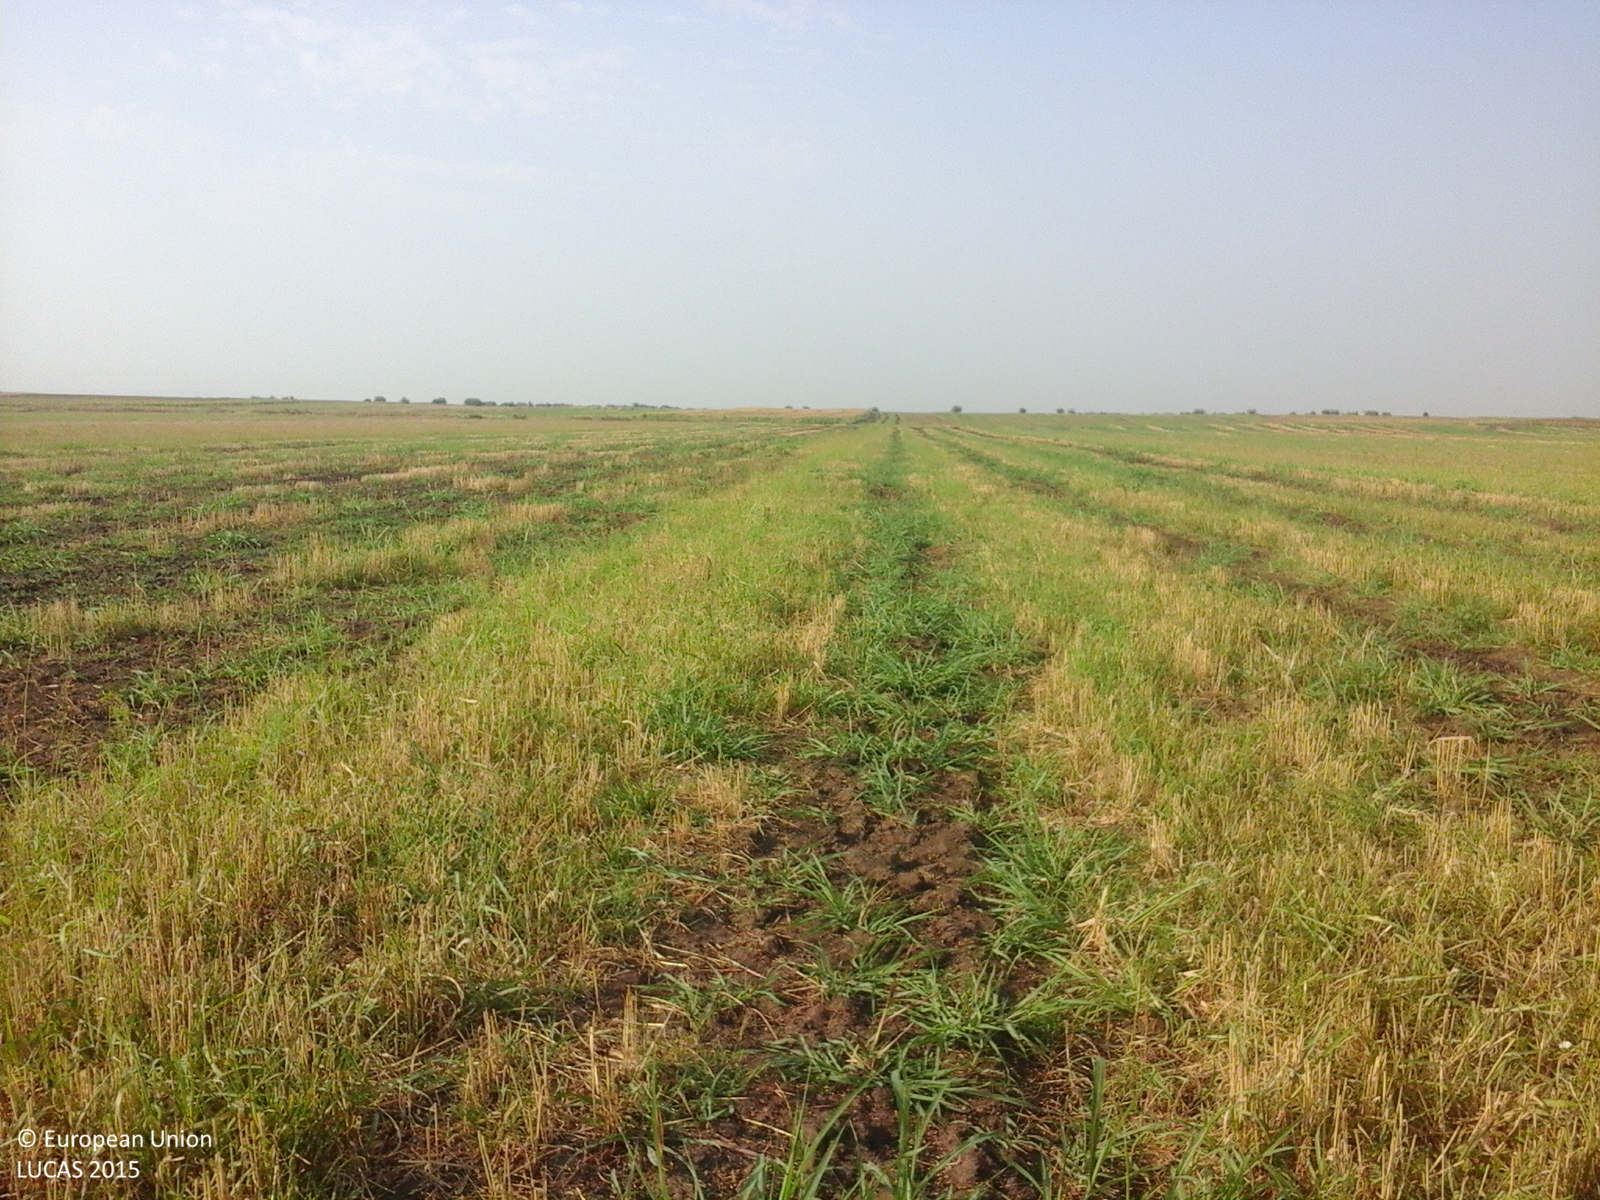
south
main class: Cropland
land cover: Common wheat
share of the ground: 50 - 75 %
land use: Agriculture (excluding fallow land and kitchen gardens)
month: August
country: RO
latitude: 44.0042
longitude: 23.2782
